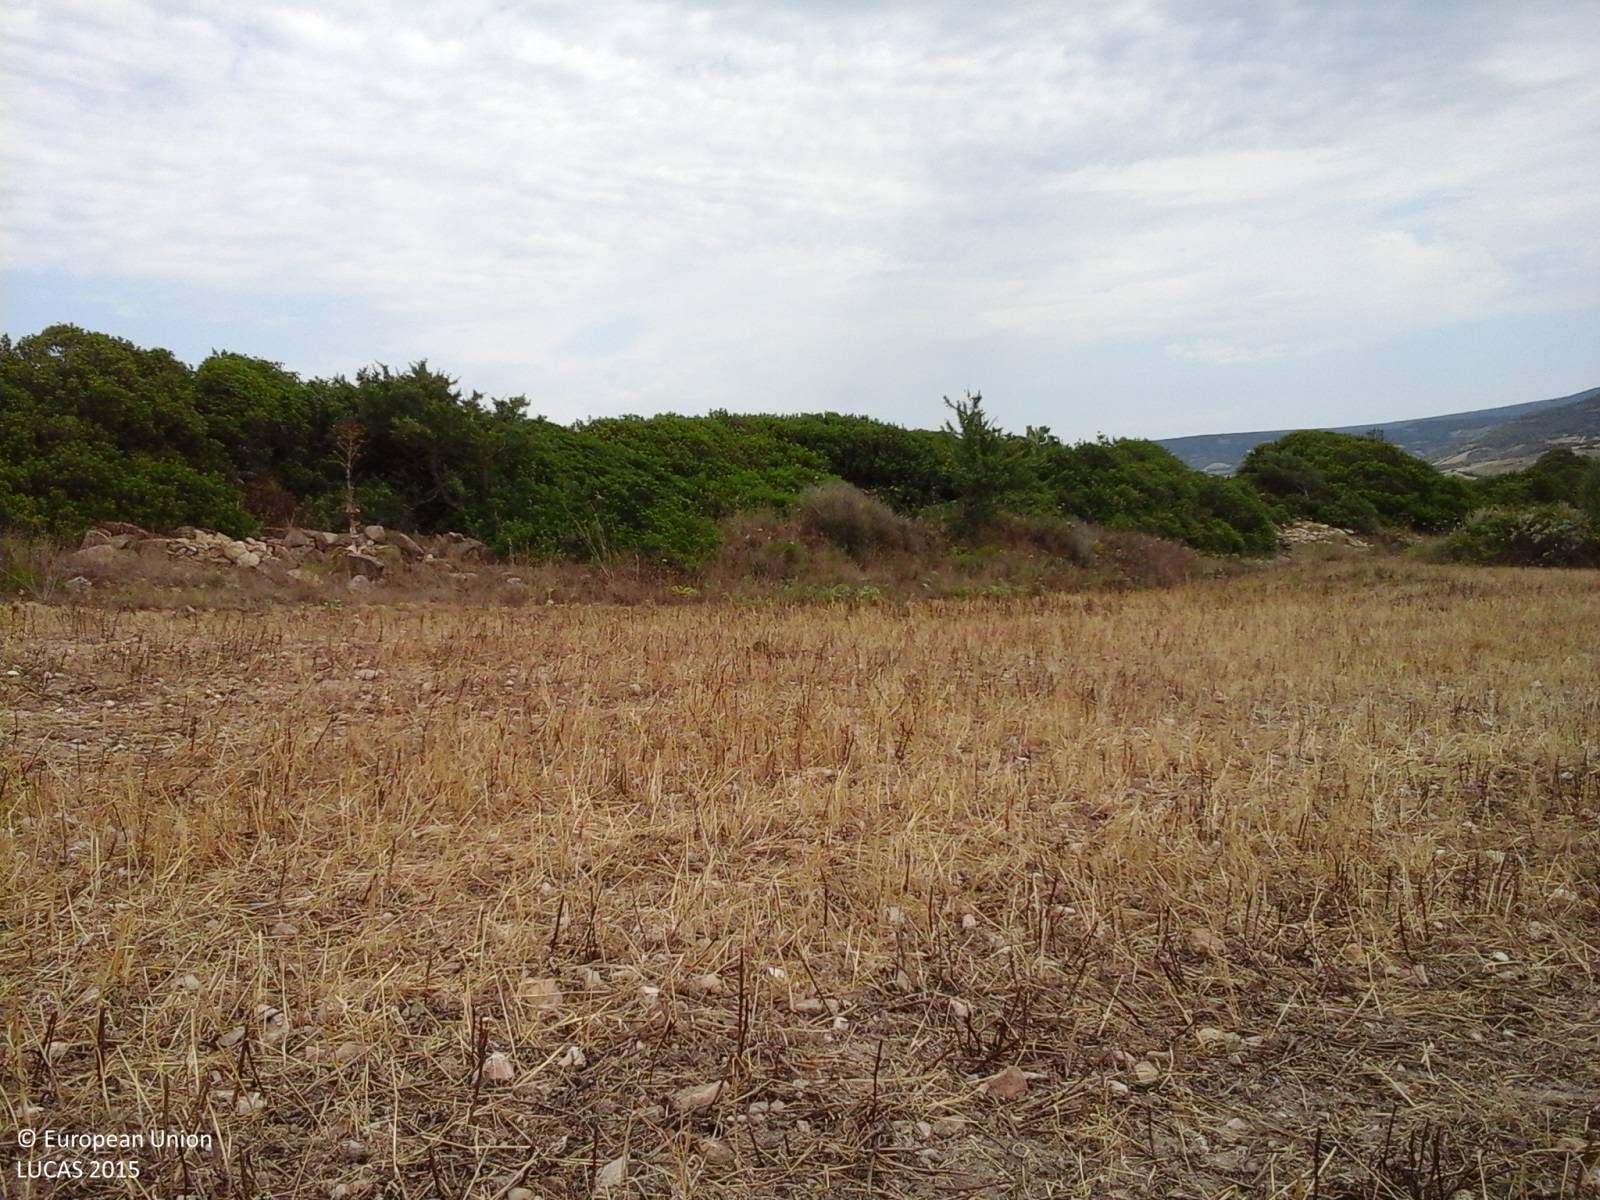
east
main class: Cropland
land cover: Dry pulses
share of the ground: > 75 %
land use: Agriculture (excluding fallow land and kitchen gardens)
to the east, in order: Dry pulses; Shrubland without tree cover; Other cereals; Shrubland without tree cover; Fences; Abandoned hedges; Tracks; Other bare soil; Shrubland without tree cover; Grassland without tree/shrub cover
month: June
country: IT
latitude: 39.9335
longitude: 8.7548
